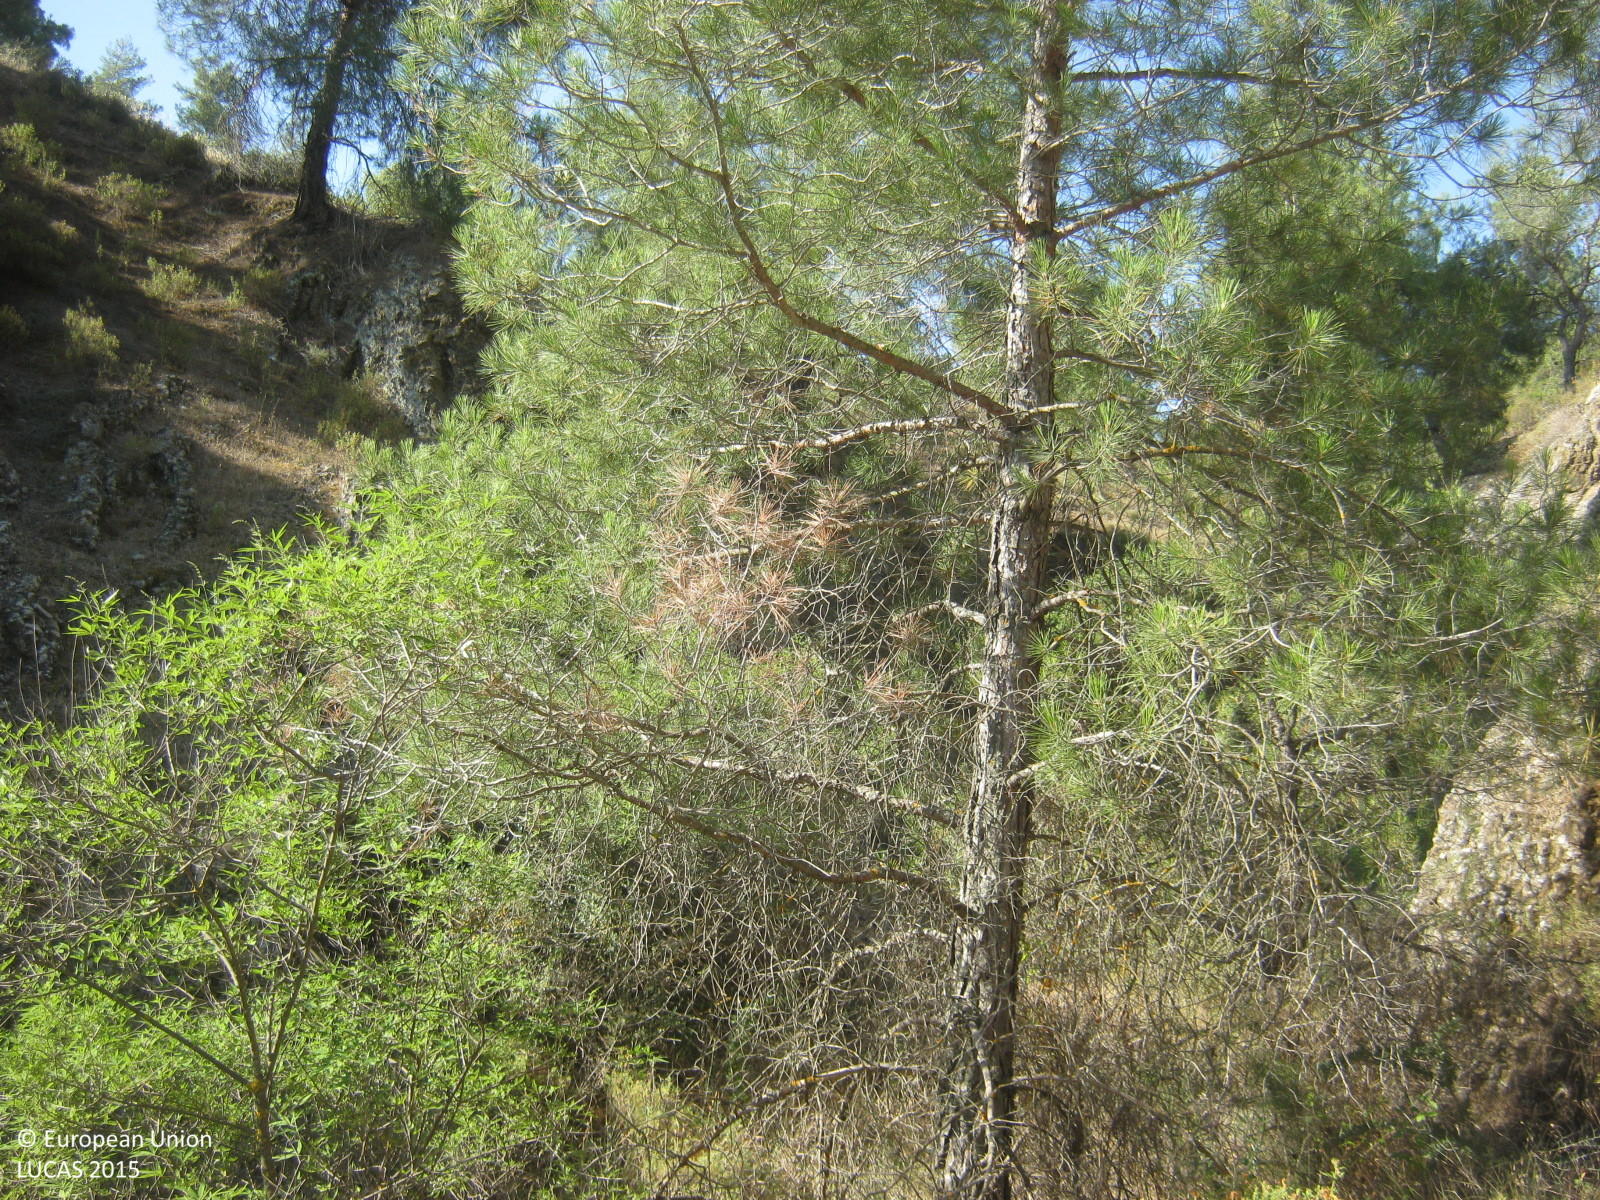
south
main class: Shrubland
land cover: Shrubland with sparse tree cover
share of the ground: 25 - 50 %
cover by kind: shrubs 30 %, herbaceous plants 30 %, consolidated bare surface 20 %, unconsolidated bare surface 15 %, coniferous forest trees 5 %
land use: Semi-natural and natural areas not in use
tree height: > 5 m
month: June
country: CY
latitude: 35.0368
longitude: 33.0770
